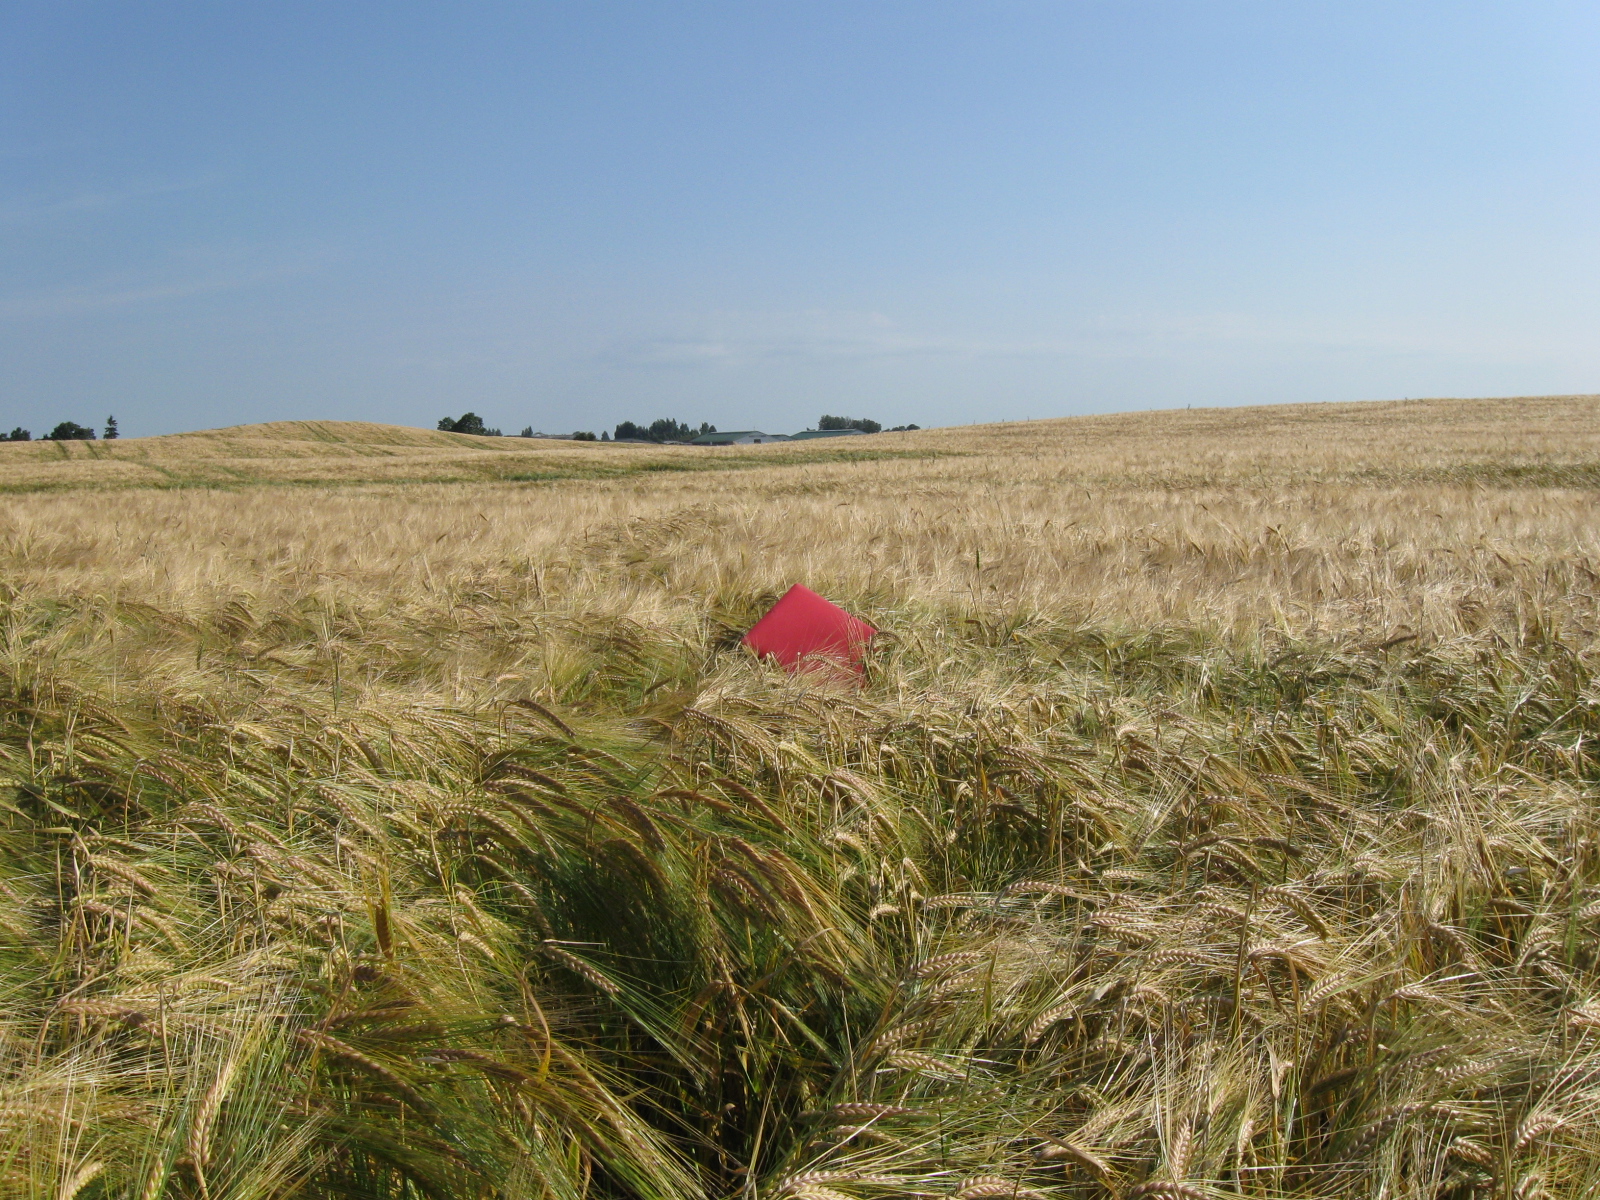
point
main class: Cropland
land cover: Barley
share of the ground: > 75 %
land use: Agriculture (excluding fallow land and kitchen gardens)
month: July
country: LT
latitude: 54.4880
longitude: 23.4650
